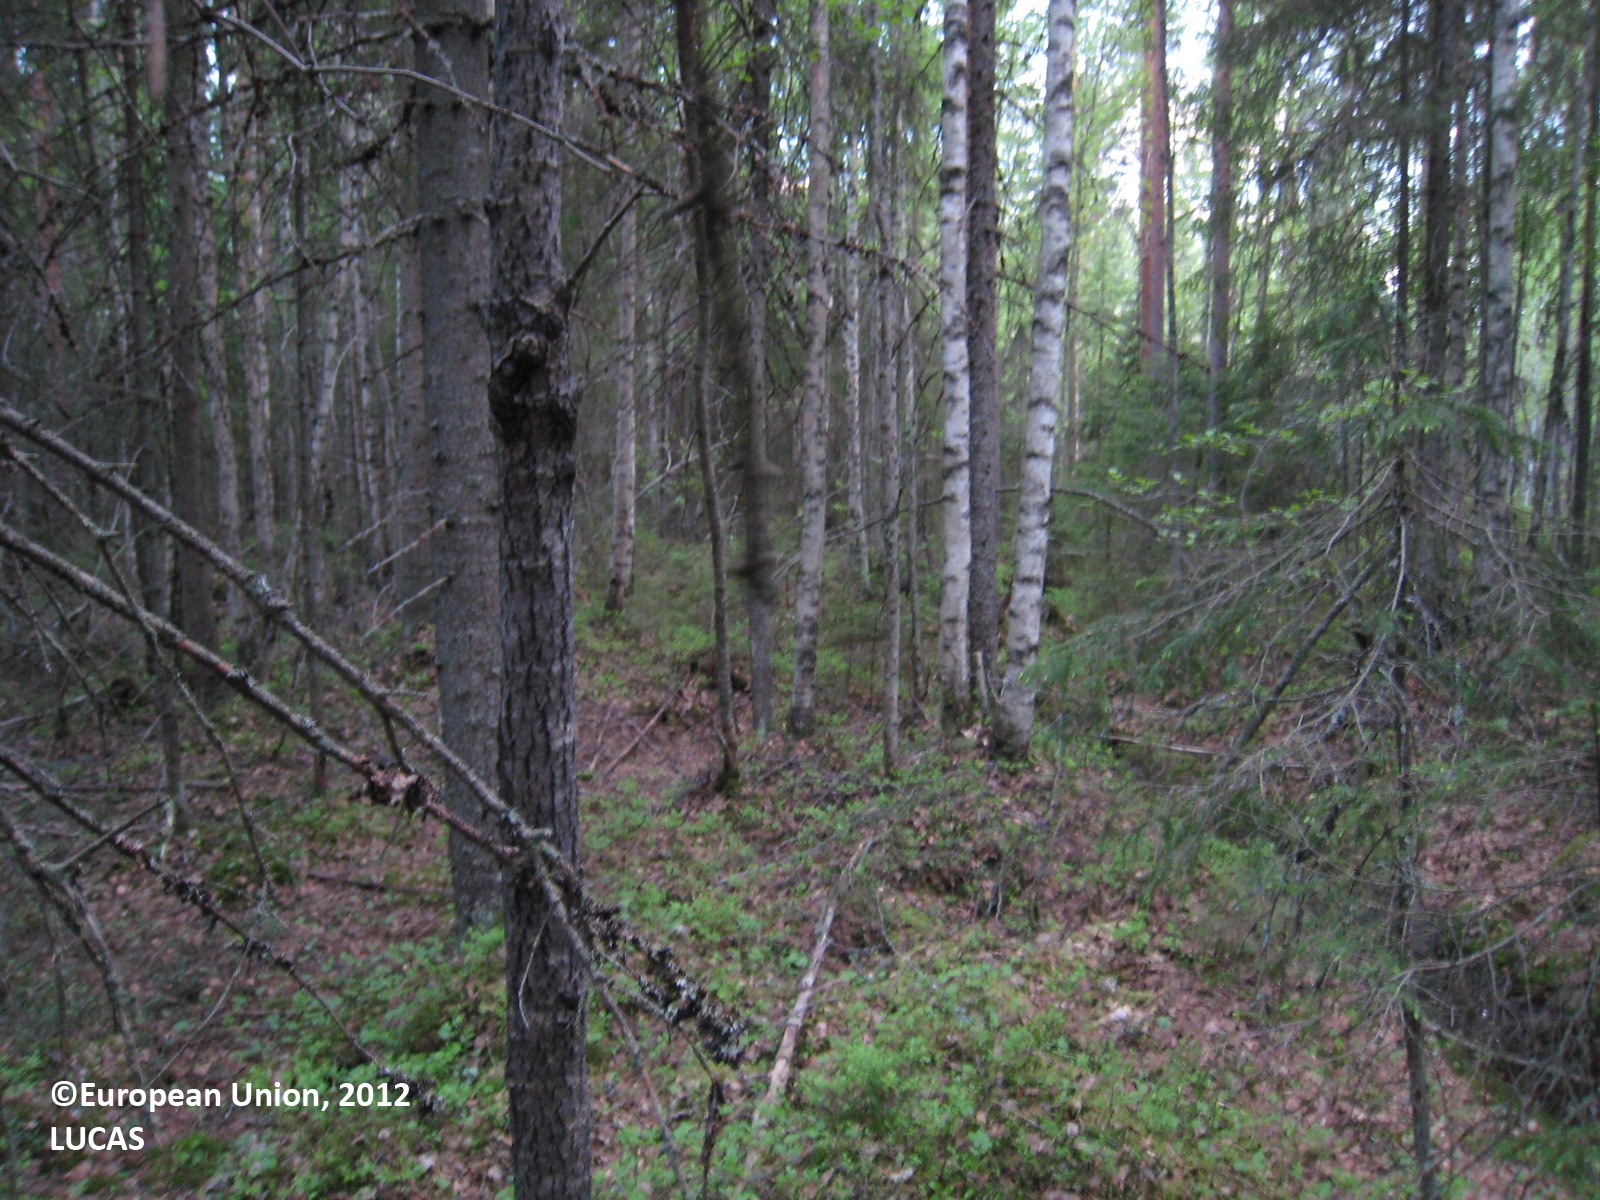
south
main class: Woodland
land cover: Spruce dominated mixed woodland
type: boreal forest
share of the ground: > 75 %
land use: Forestry
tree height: > 5 m
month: June
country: FI
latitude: 62.5686
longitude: 26.1005
